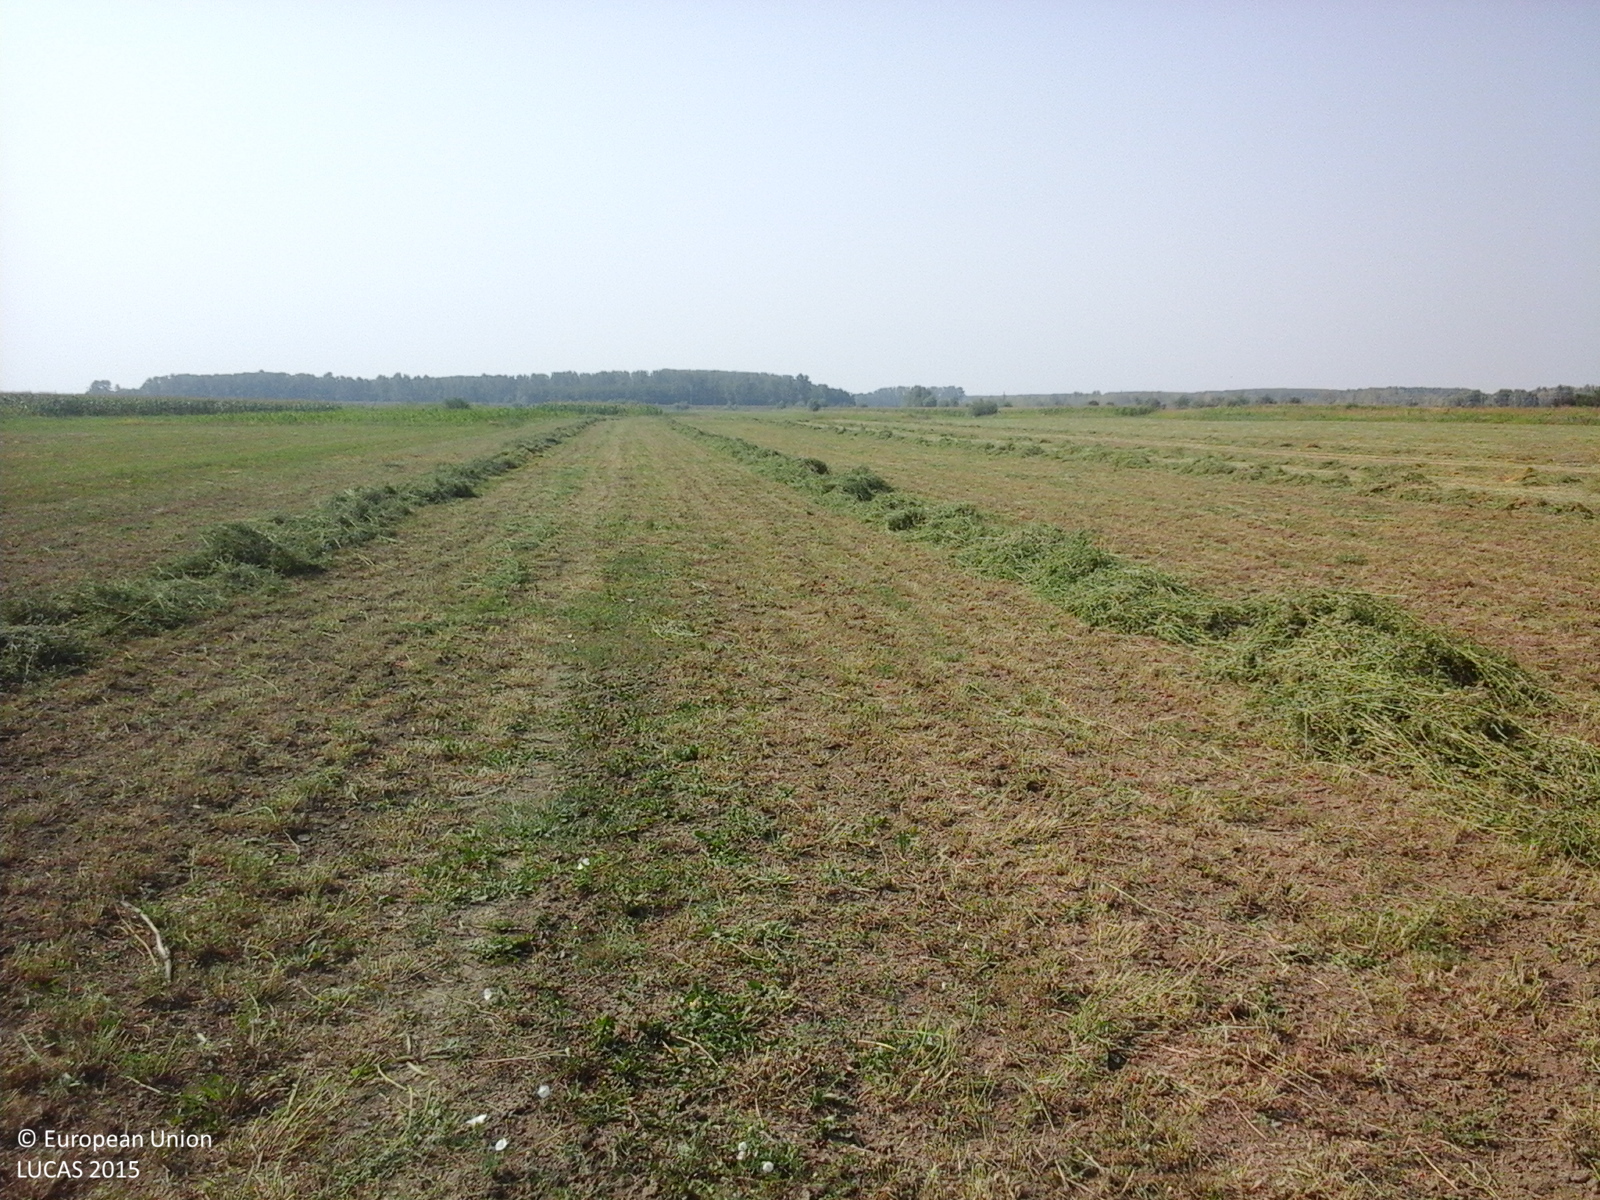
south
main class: Cropland
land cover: Lucerne
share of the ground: 10 - 25 %
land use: Agriculture (excluding fallow land and kitchen gardens)
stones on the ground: < 10 %
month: July
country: RO
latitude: 45.6505
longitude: 27.4906
